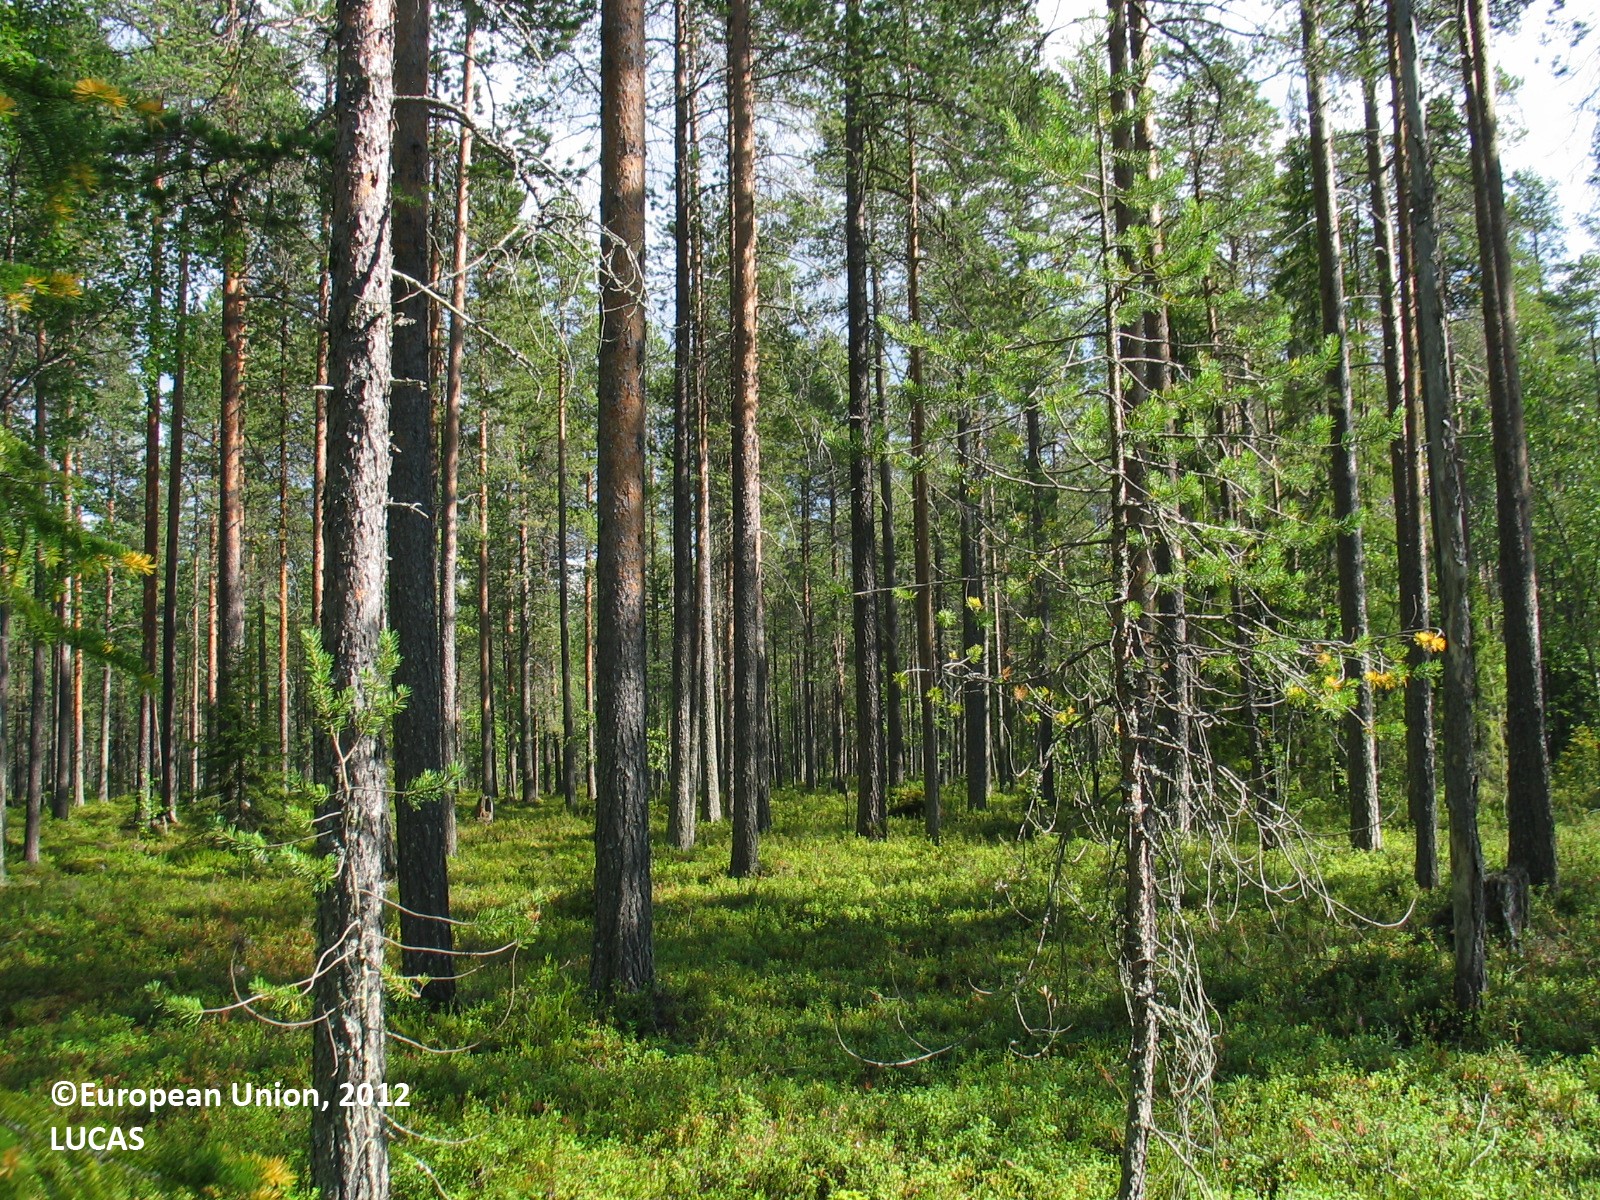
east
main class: Woodland
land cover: Pine dominated coniferous woodland
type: boreal forest
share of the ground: 25 - 50 %
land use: Forestry
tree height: > 5 m
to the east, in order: Pine dominated coniferous woodland
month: August
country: FI
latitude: 65.7032
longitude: 25.8741
